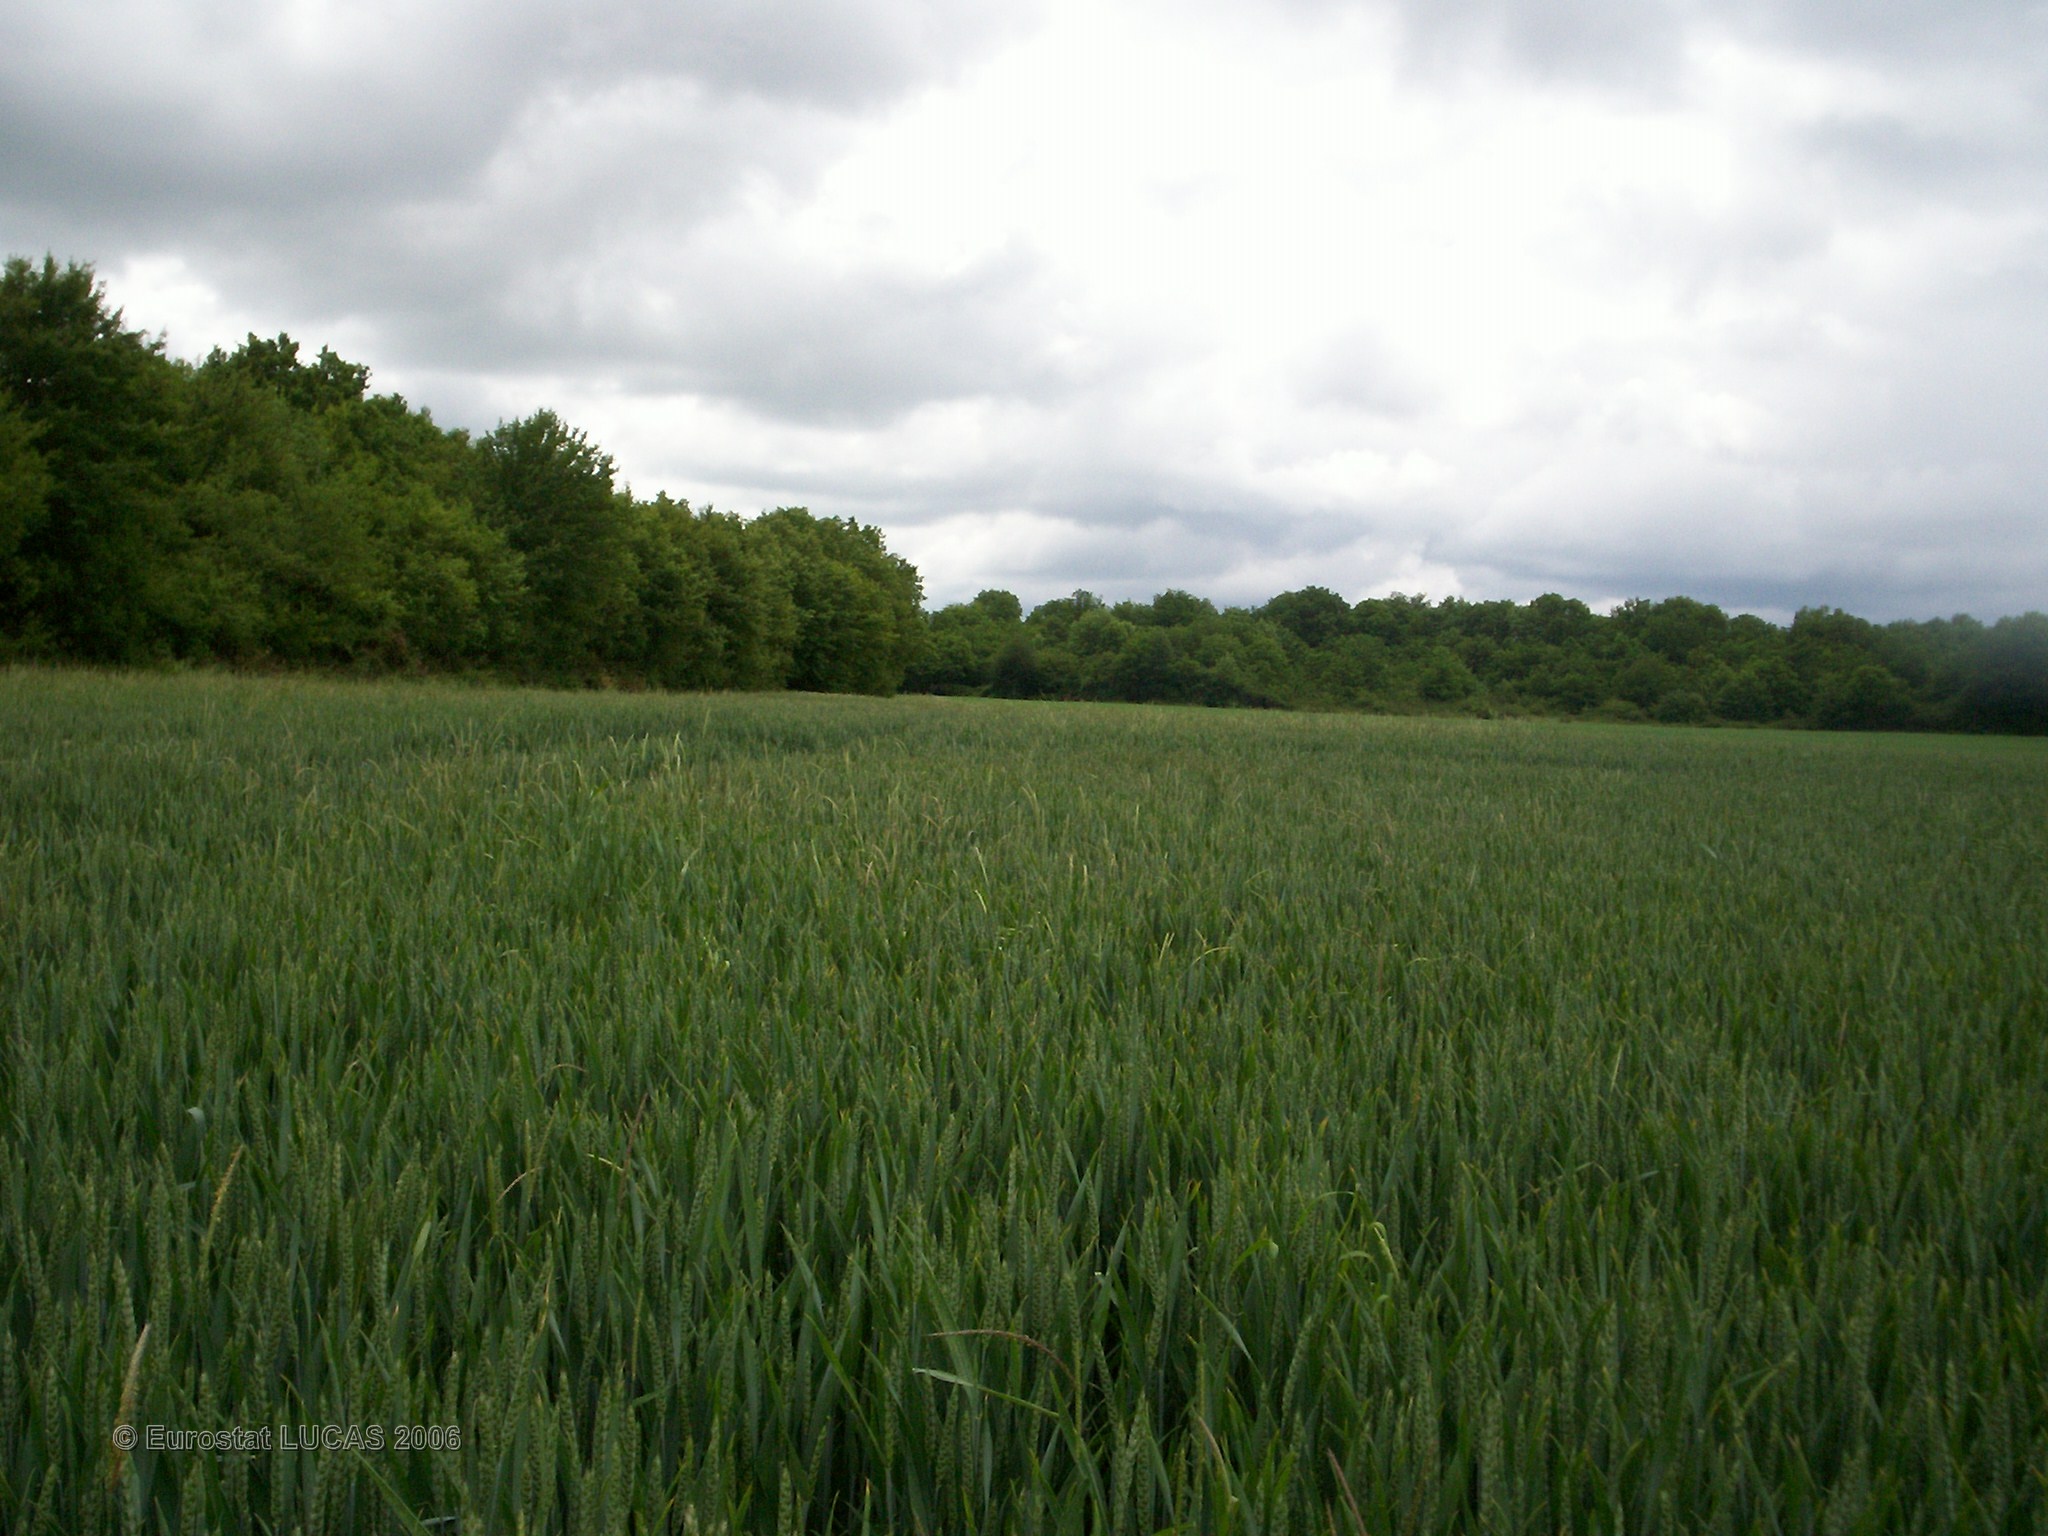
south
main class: Cropland
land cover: Common wheat
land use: Agriculture (excluding fallow land and kitchen gardens)
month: May
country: FR
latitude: 47.6089
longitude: 3.9980
